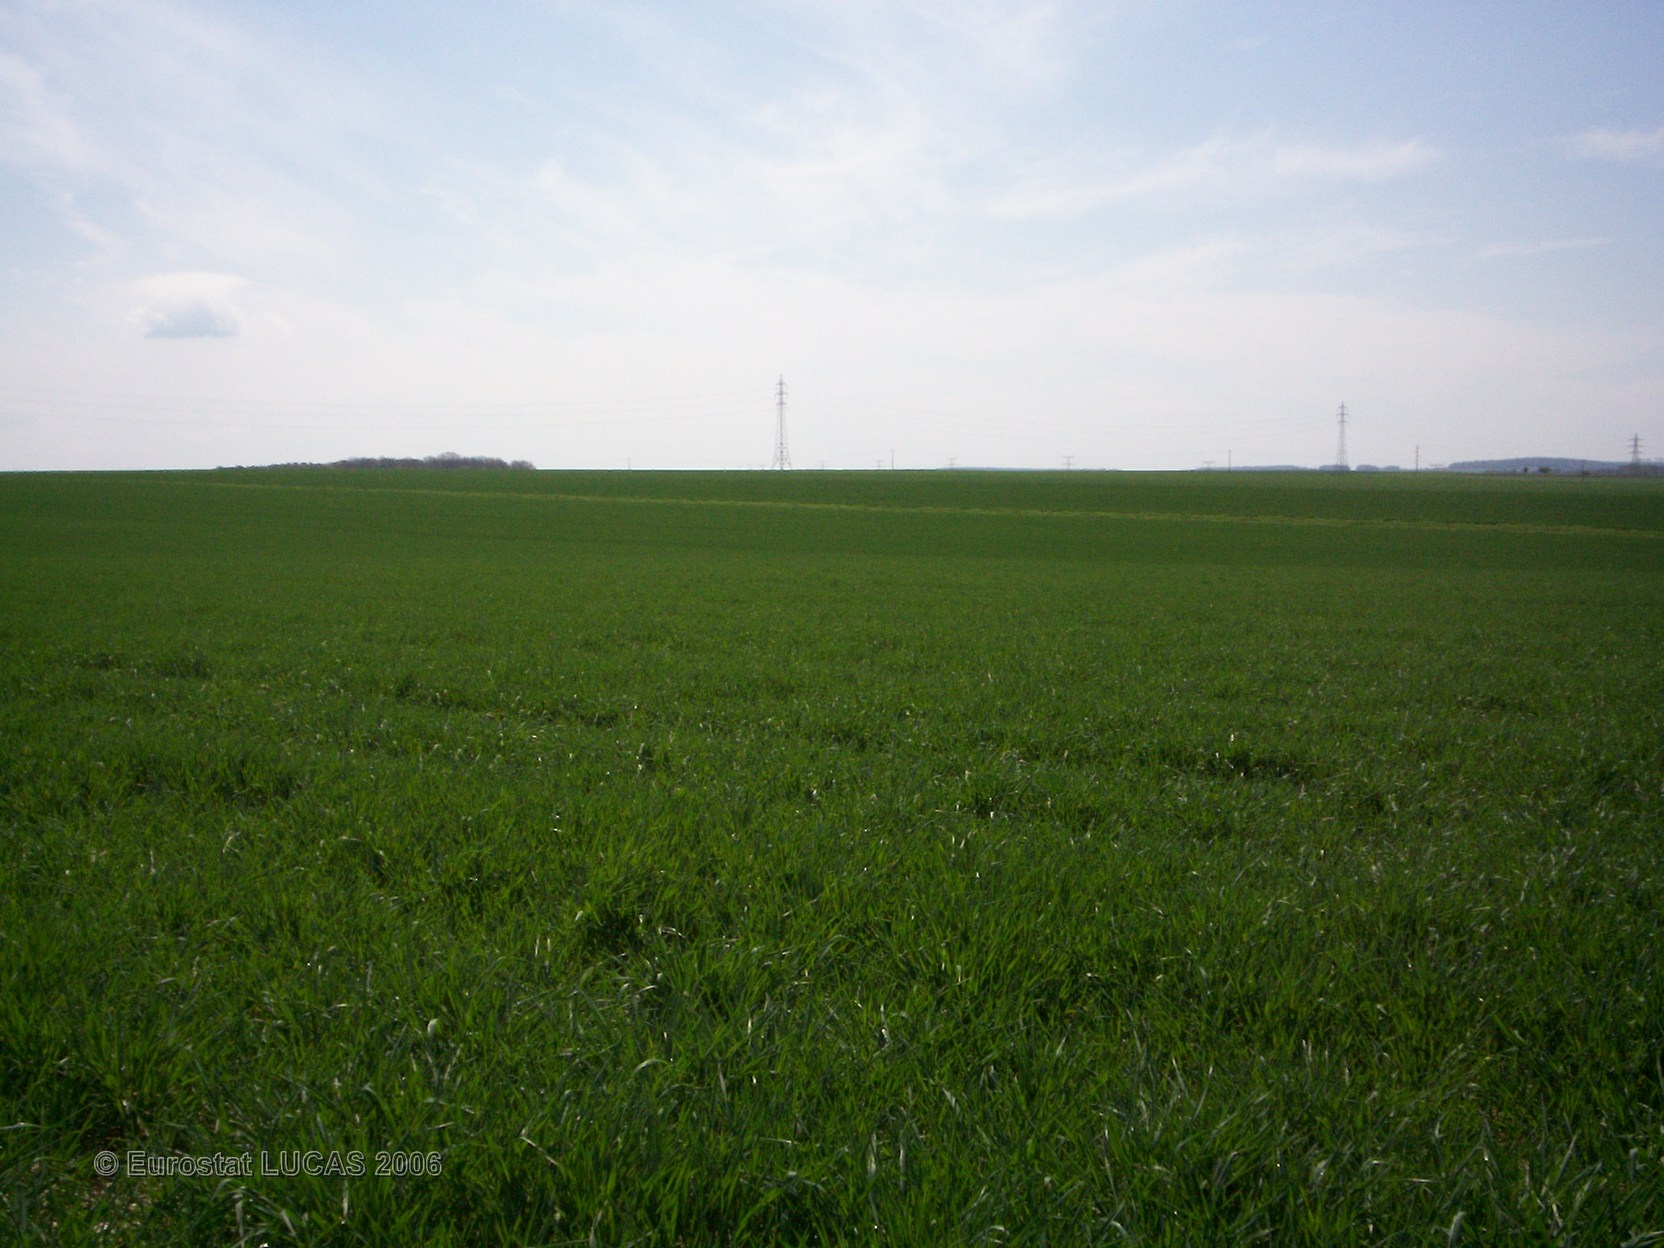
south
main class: Cropland
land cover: Common wheat
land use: Agriculture (excluding fallow land and kitchen gardens)
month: April
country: FR
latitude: 47.3697
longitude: 3.0158
